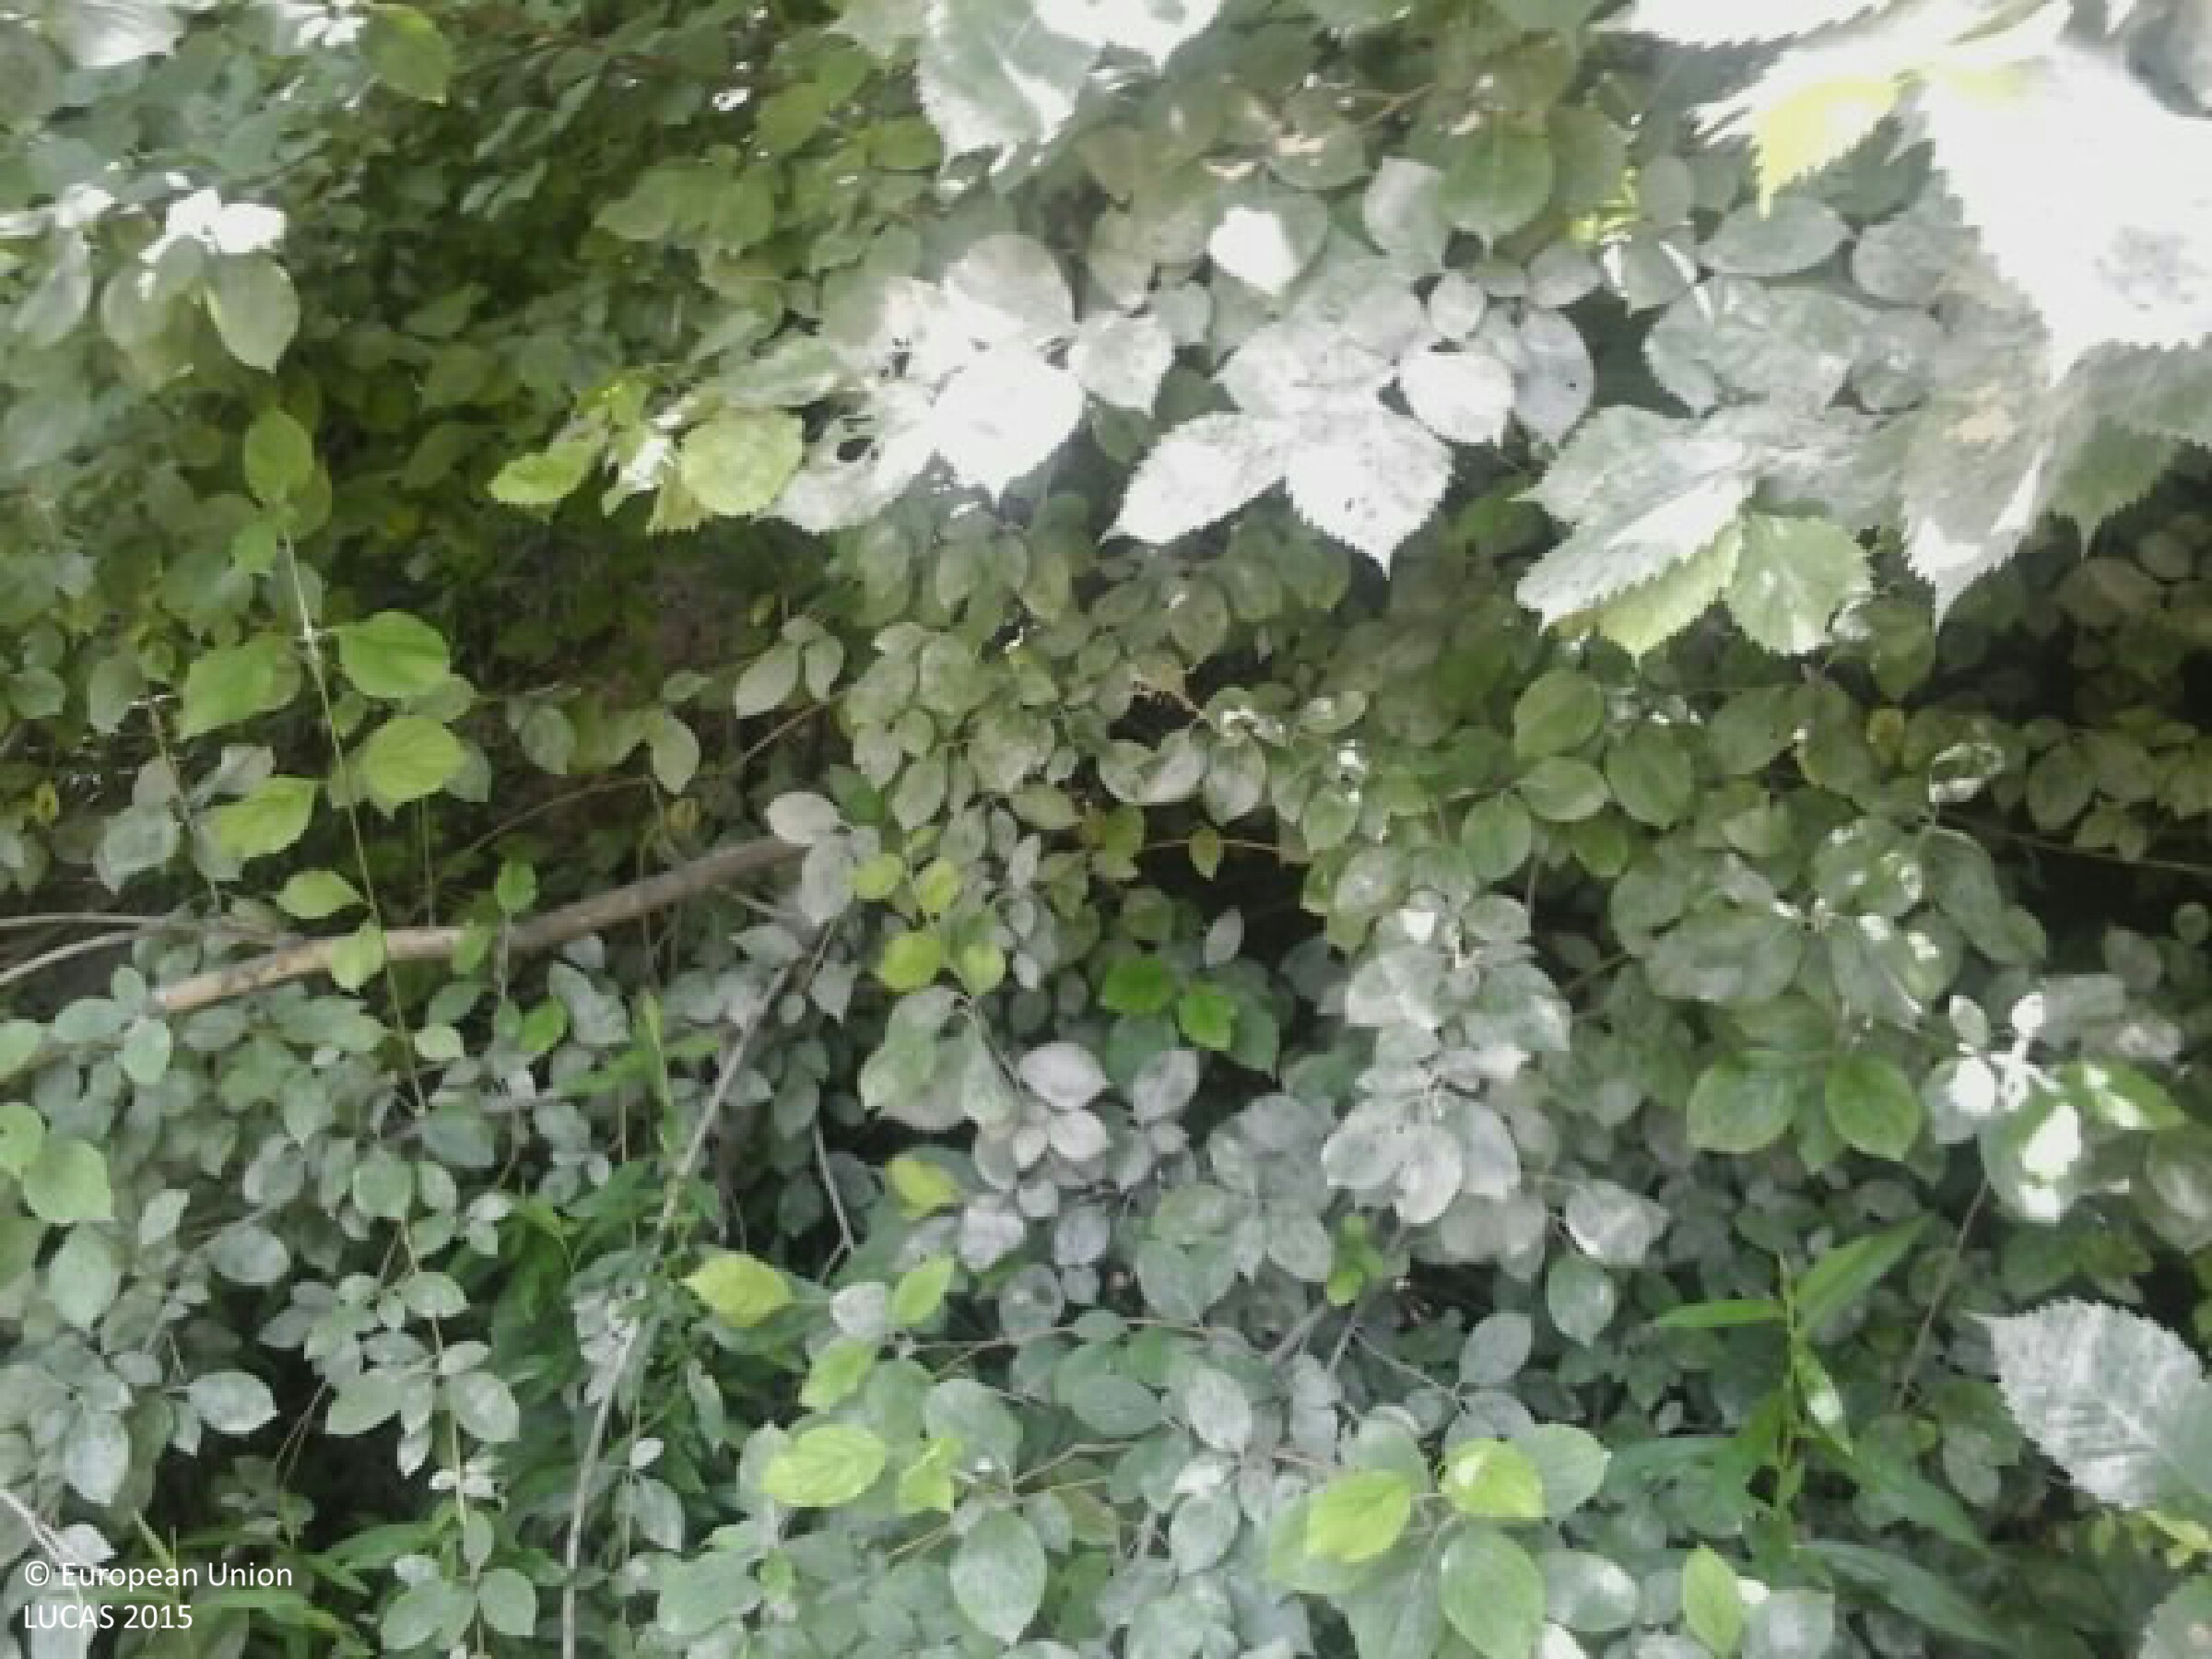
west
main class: Woodland
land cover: Broadleaved woodland
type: mesophytic deciduous forest
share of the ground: > 75 %
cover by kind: broadleaved forest trees 75 %, unconsolidated bare surface 20 %, herbaceous plants 5 %
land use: Semi-natural and natural areas not in use
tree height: > 5 m
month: June
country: HU
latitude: 46.8653
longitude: 18.9218
